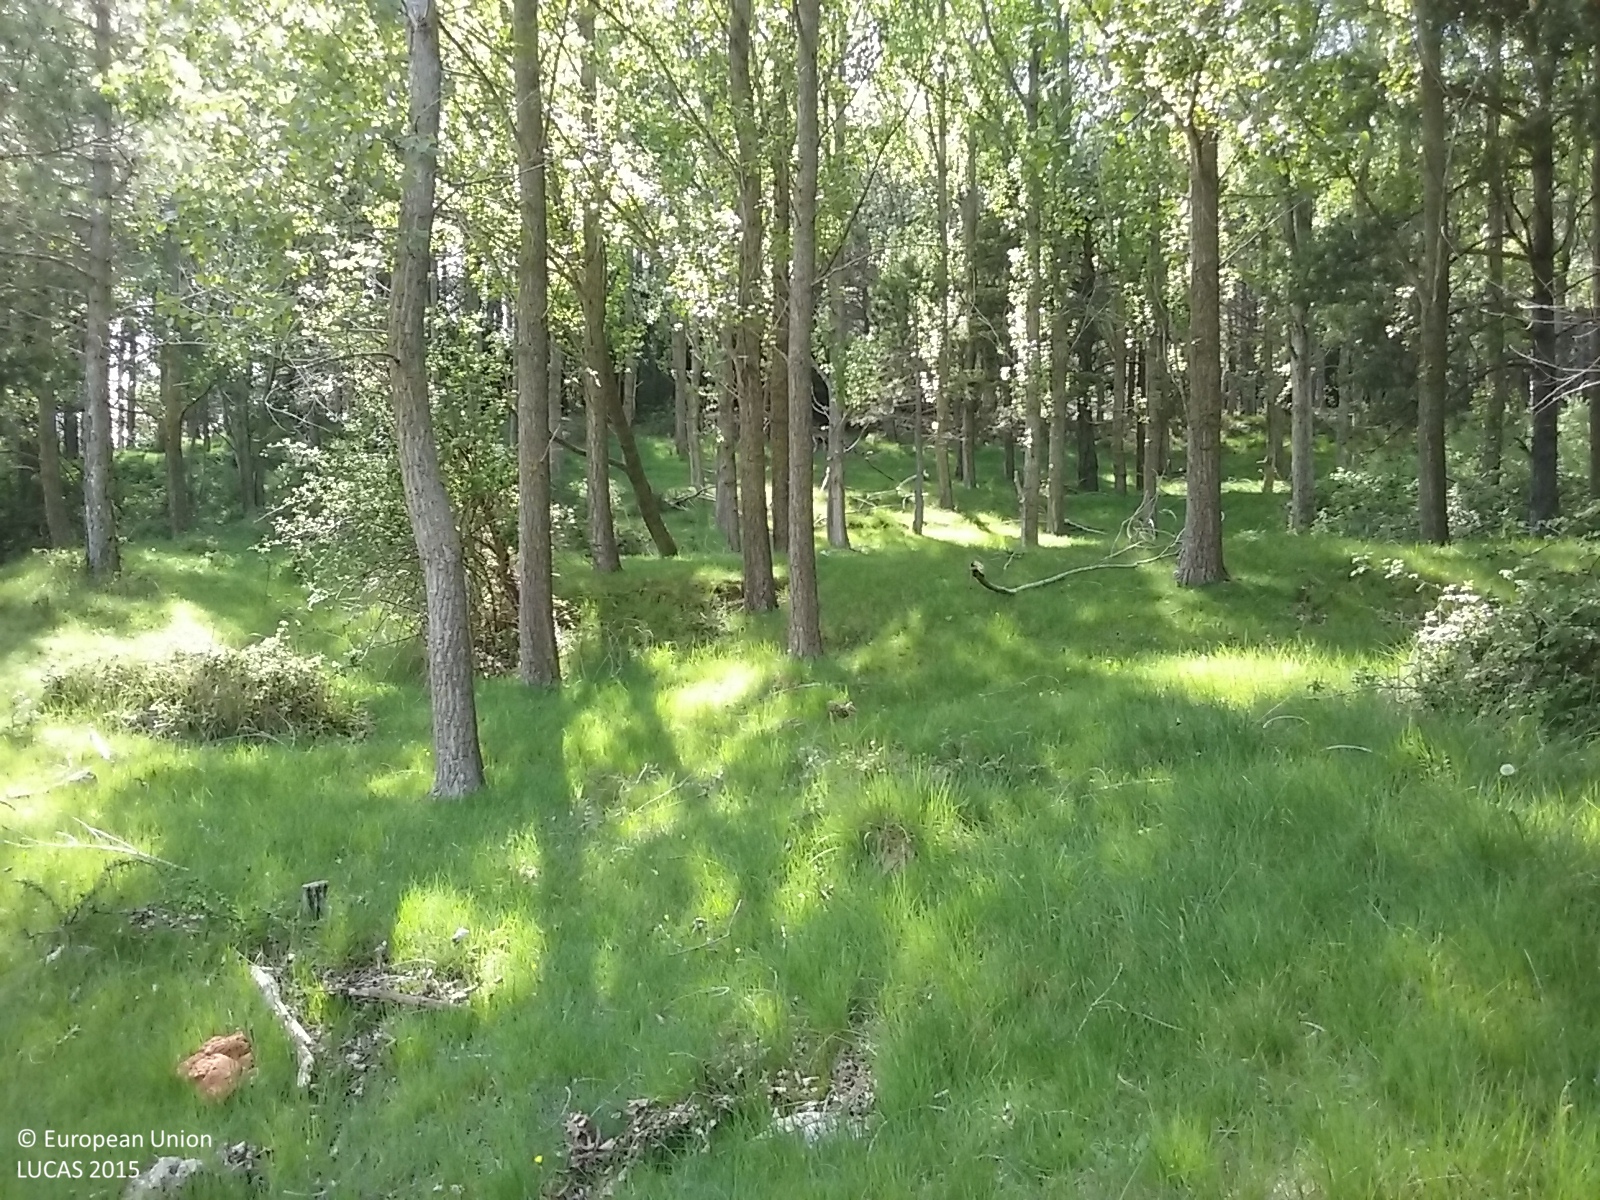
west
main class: Woodland
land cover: Pine dominated coniferous woodland
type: coniferous forest of the mediterranean region
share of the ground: > 75 %
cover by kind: coniferous forest trees 85 %, broadleaved forest trees 5 %, unconsolidated bare surface 5 %
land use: Forestry
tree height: > 5 m
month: May
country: ES
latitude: 40.7678
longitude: 0.2905
